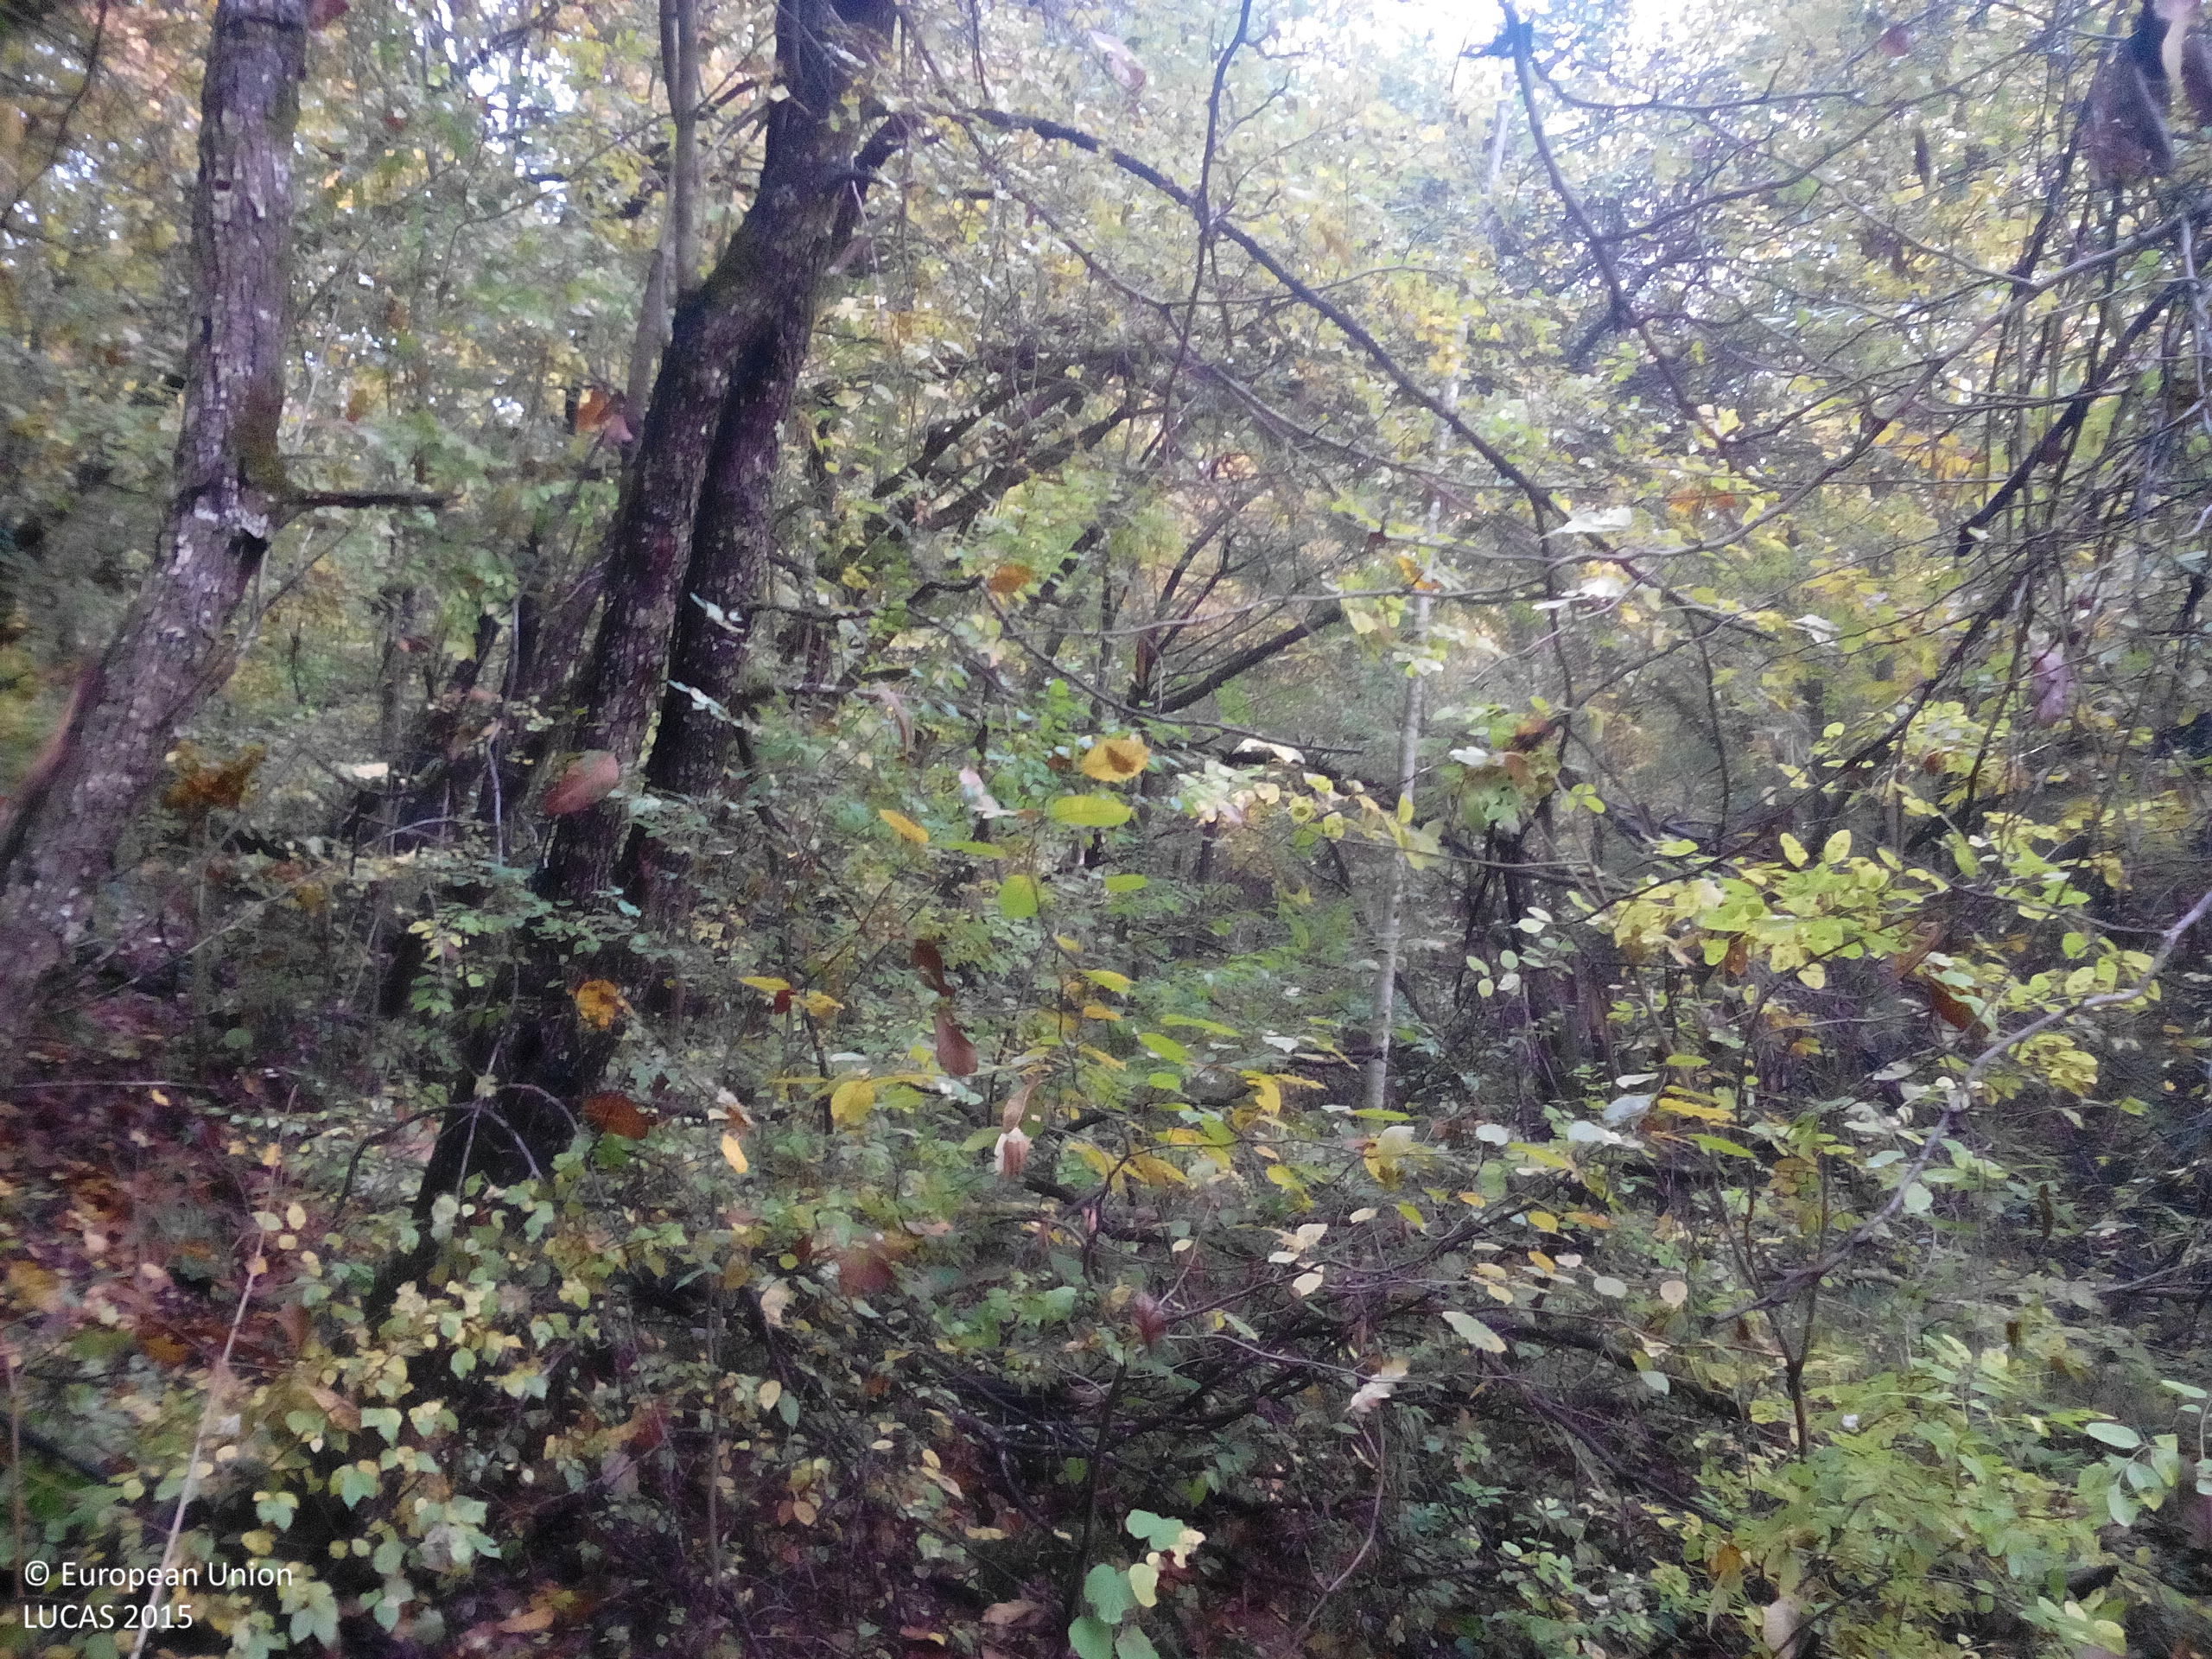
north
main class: Woodland
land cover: Broadleaved woodland
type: beech forest
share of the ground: > 75 %
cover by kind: broadleaved forest trees 95 %, shrubs 5 %
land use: Forestry
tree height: > 5 m
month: October
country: BG
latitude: 43.0218
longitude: 24.4498
